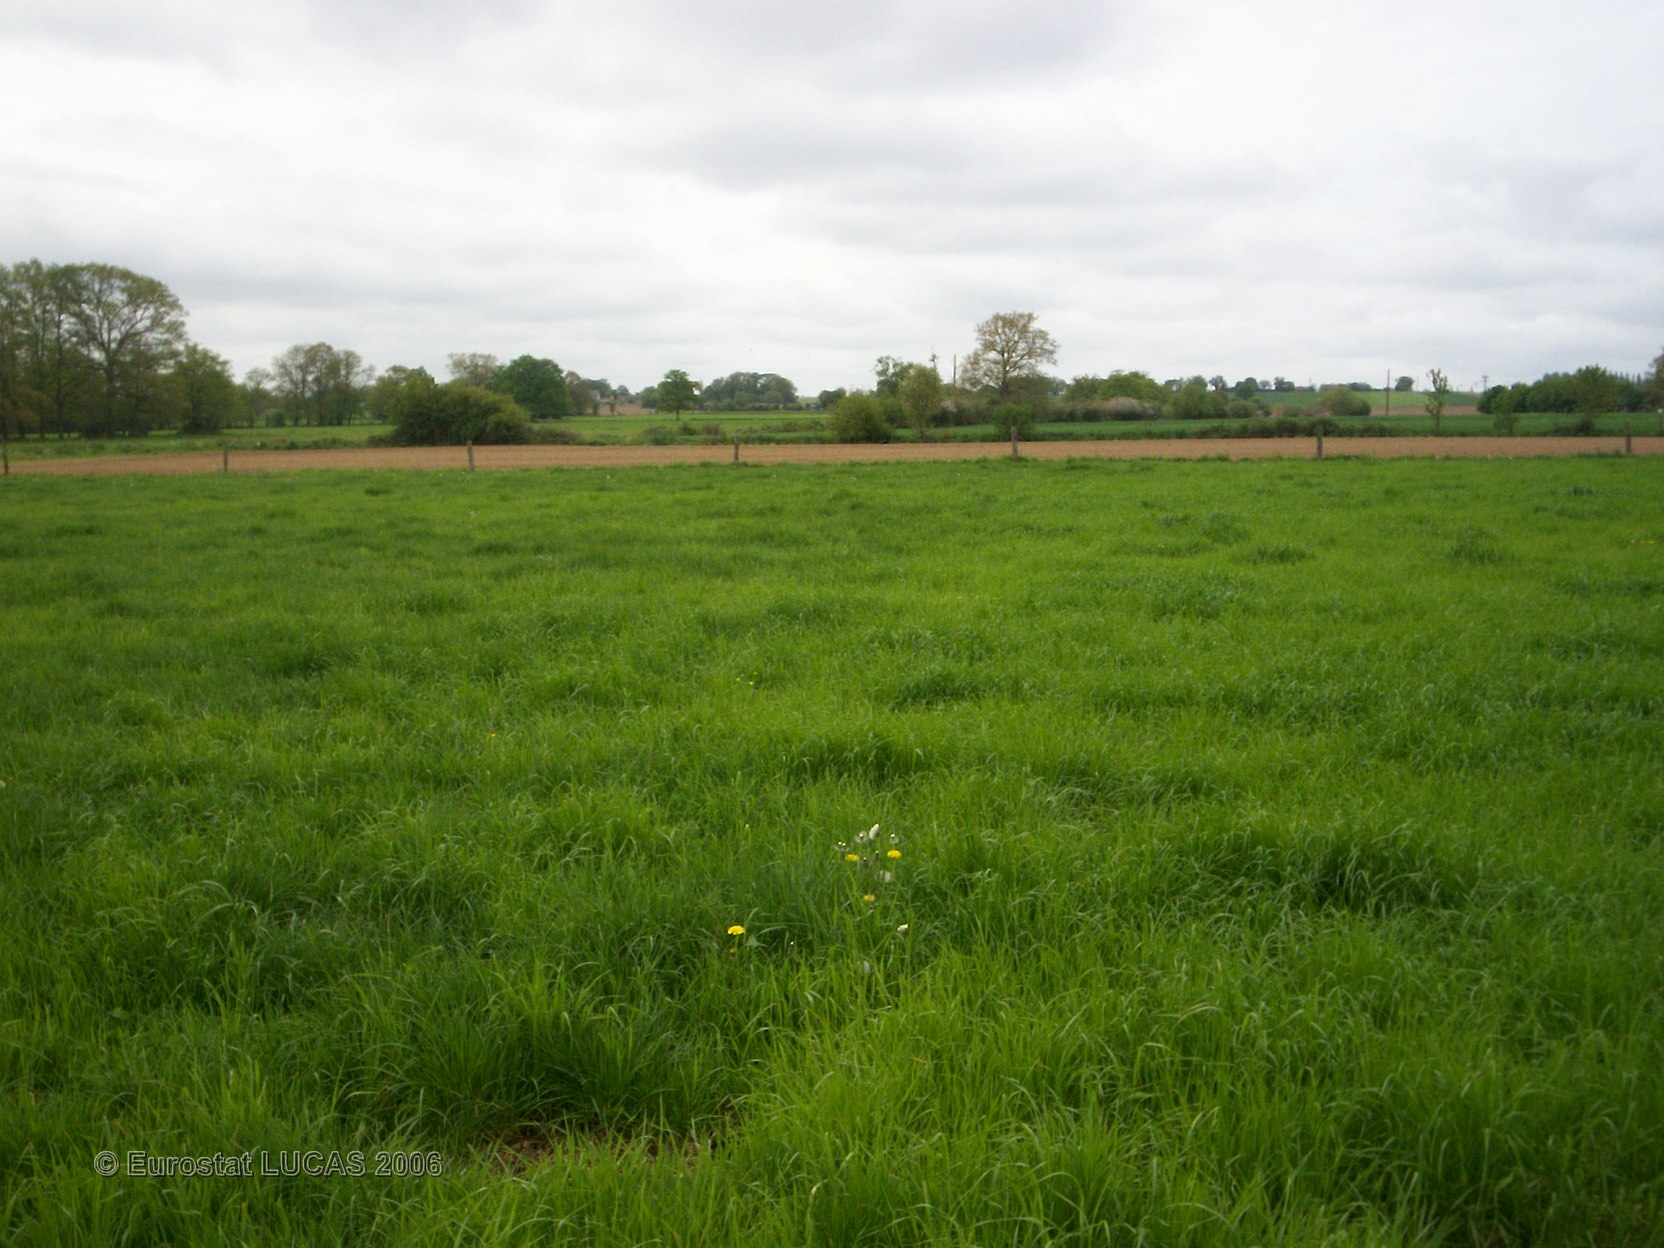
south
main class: Grassland
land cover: Grassland without tree/shrub cover
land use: Agriculture (excluding fallow land and kitchen gardens)
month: May
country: FR
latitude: 47.8248
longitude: -1.2752
